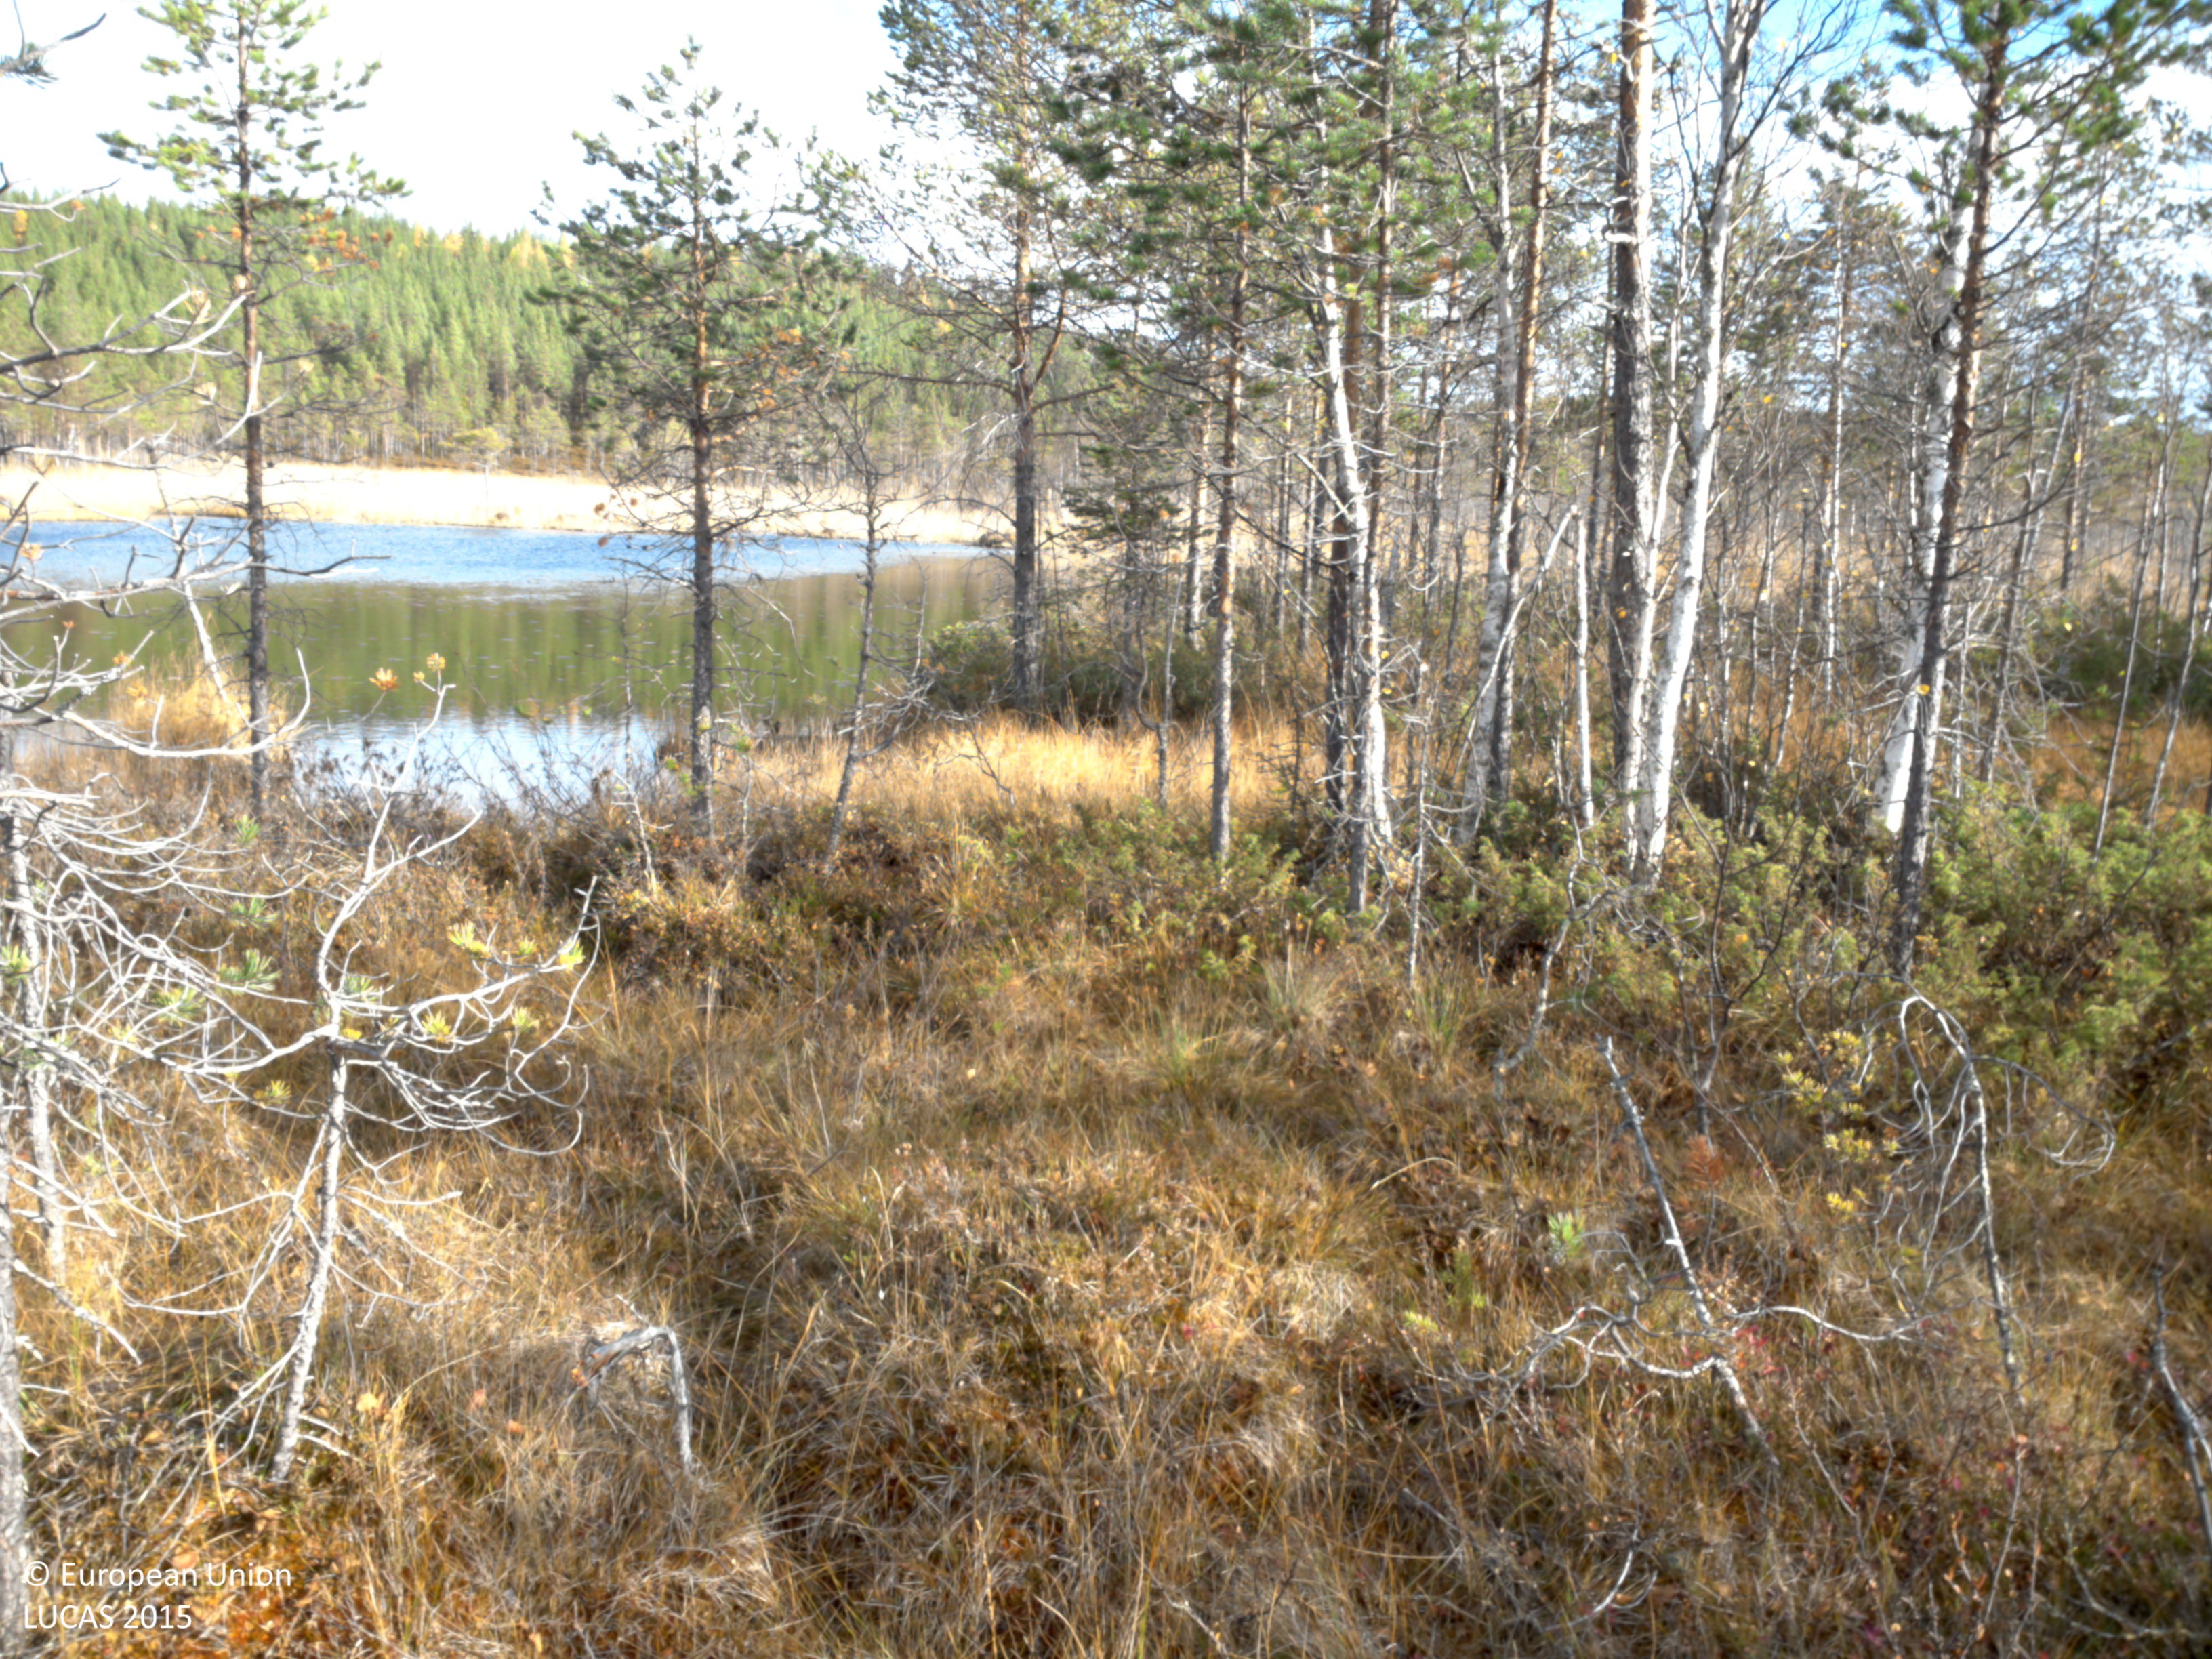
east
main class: Woodland
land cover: Pine dominated coniferous woodland
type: boreal forest
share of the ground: 25 - 50 %
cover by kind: coniferous forest trees 40 %, shrubs 20 %, herbaceous plants 20 %, broadleaved forest trees 10 %, lichens and mosses 10 %
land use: Semi-natural and natural areas not in use
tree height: < 5 m
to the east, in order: Pine dominated coniferous woodland; Inland fresh water bodies; Inland marshes; Pine dominated coniferous woodland; Inland marshes; Pine dominated coniferous woodland
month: September
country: SE
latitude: 64.8763
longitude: 18.5568
